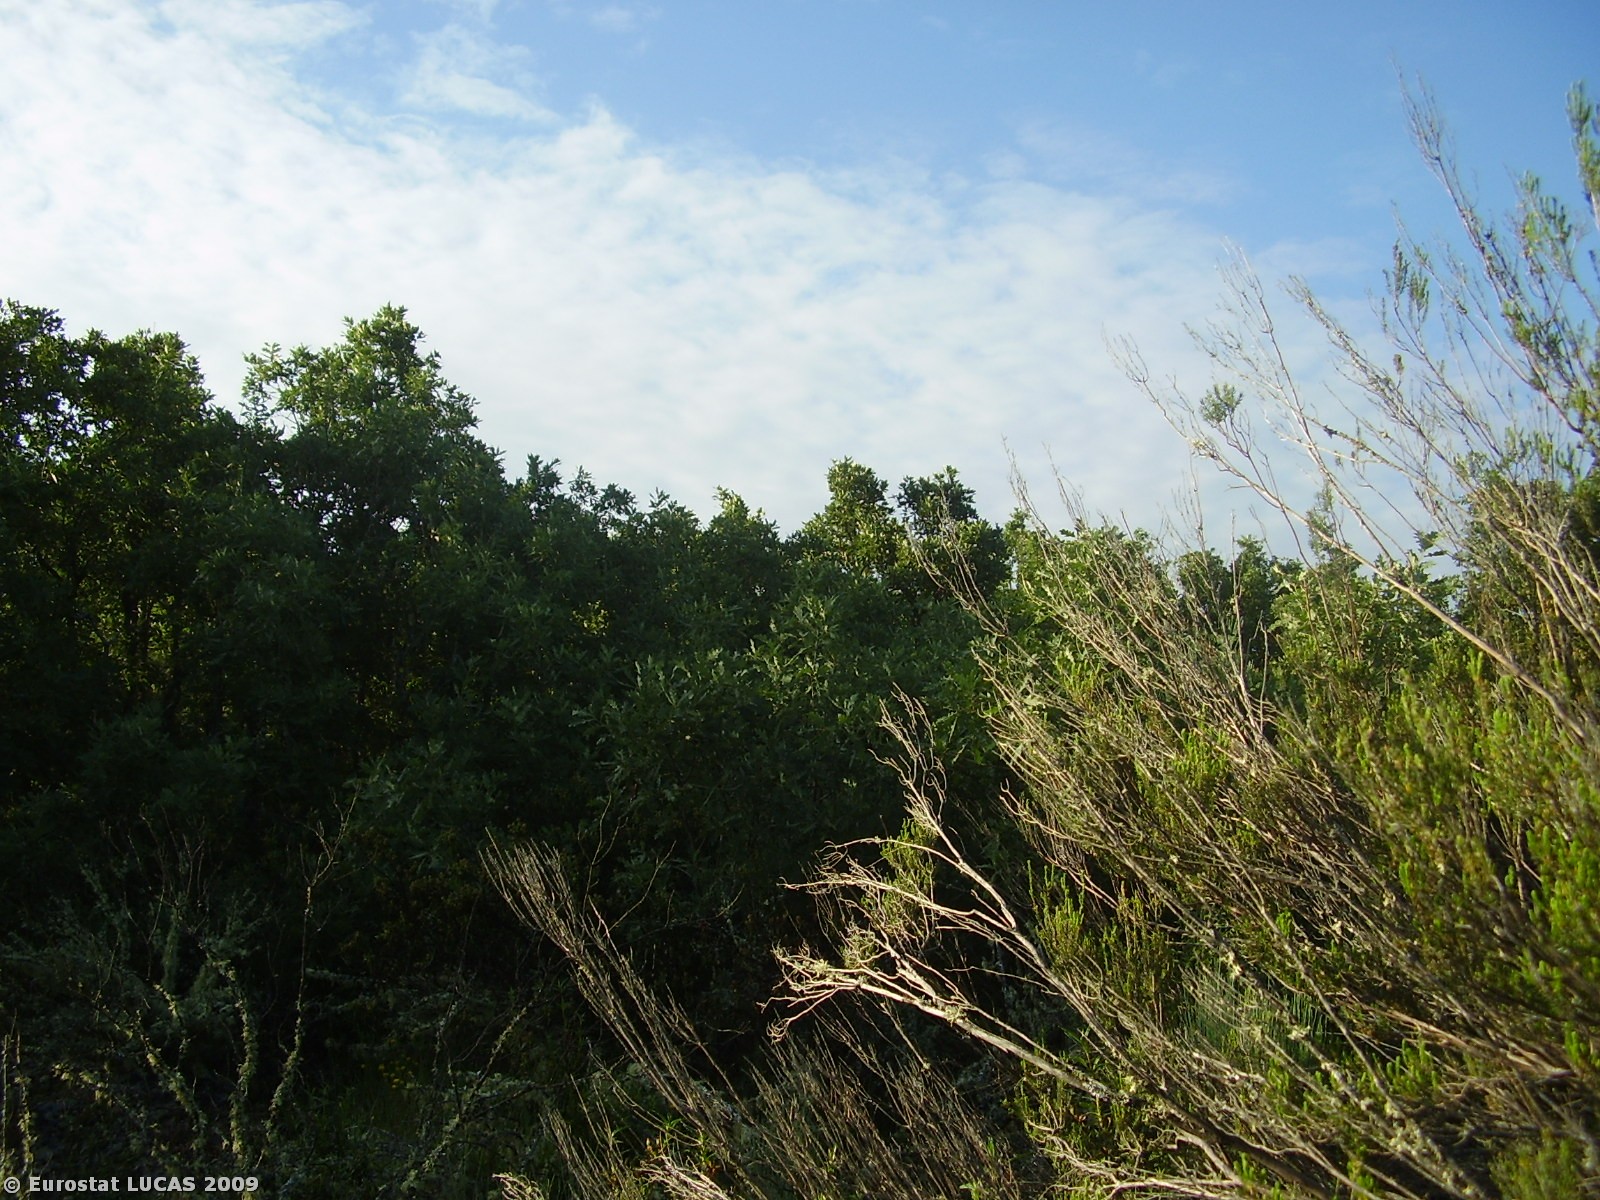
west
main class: Woodland
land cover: Broadleaved woodland
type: thermophilous deciduous forest
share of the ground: > 75 %
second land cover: Spontaneously vegetated surfaces
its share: 10 - 25 %
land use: Nature reserves
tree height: > 5 m
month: June
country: PT
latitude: 41.8176
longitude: -6.8614
